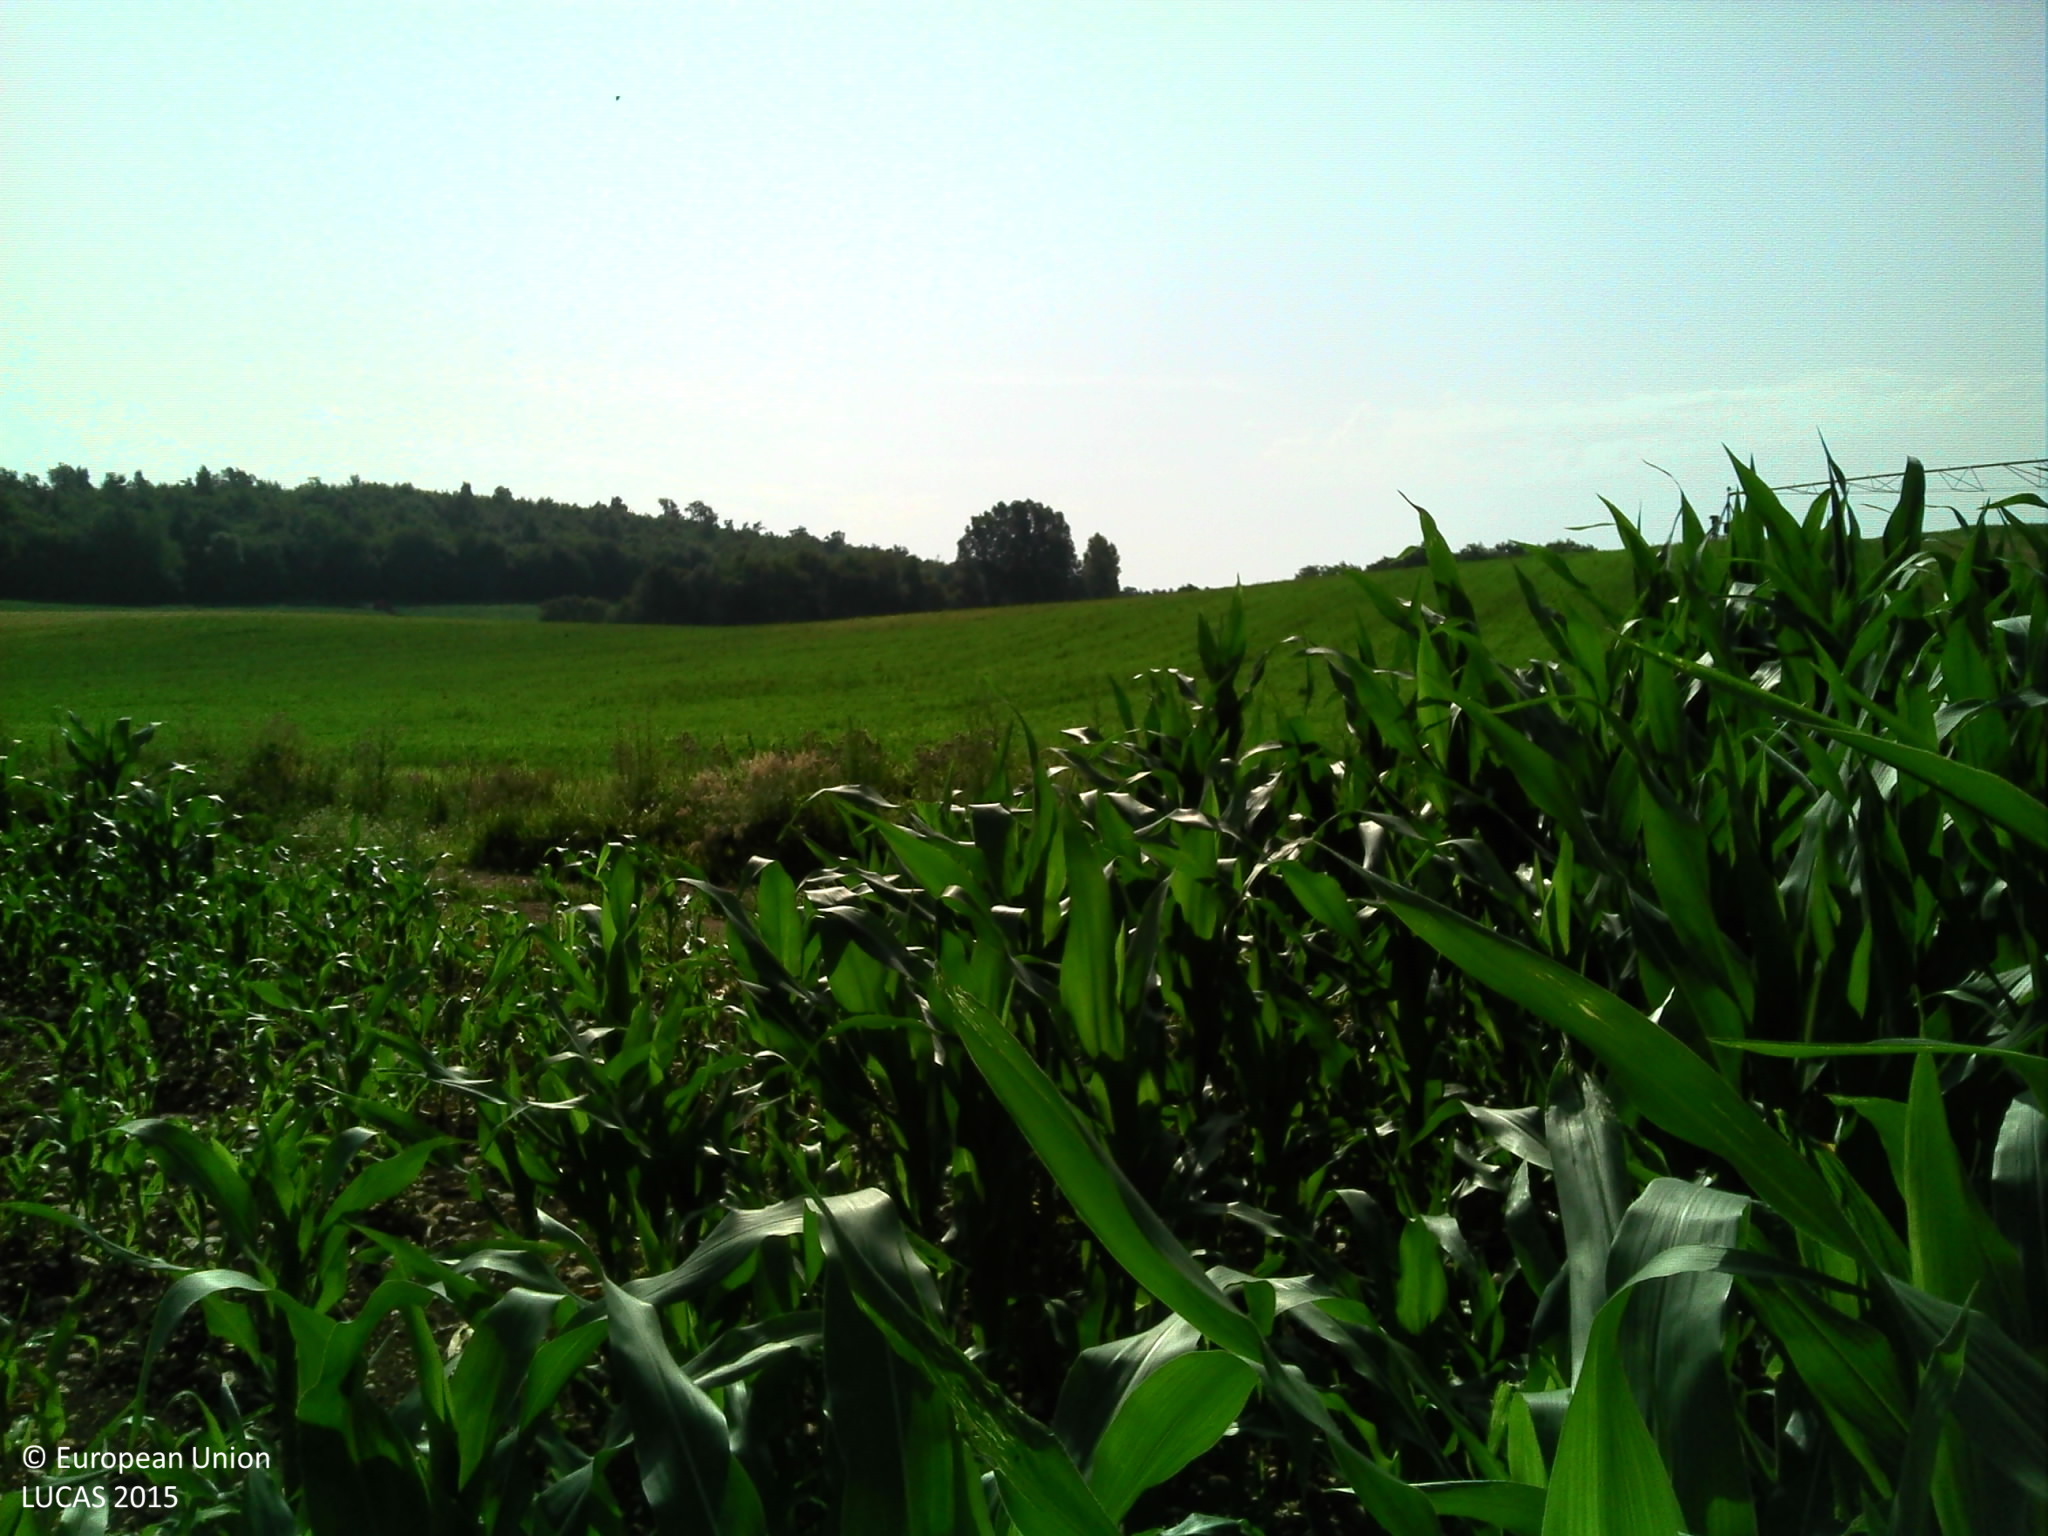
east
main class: Cropland
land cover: Maize
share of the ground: > 75 %
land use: Agriculture (excluding fallow land and kitchen gardens)
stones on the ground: 10 - 25 %
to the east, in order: Maize; Grass margins; Tracks; Grass margins; Ditches and canals; Temporary grasslands; Oats
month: July
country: FR
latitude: 45.7646
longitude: 5.3880
